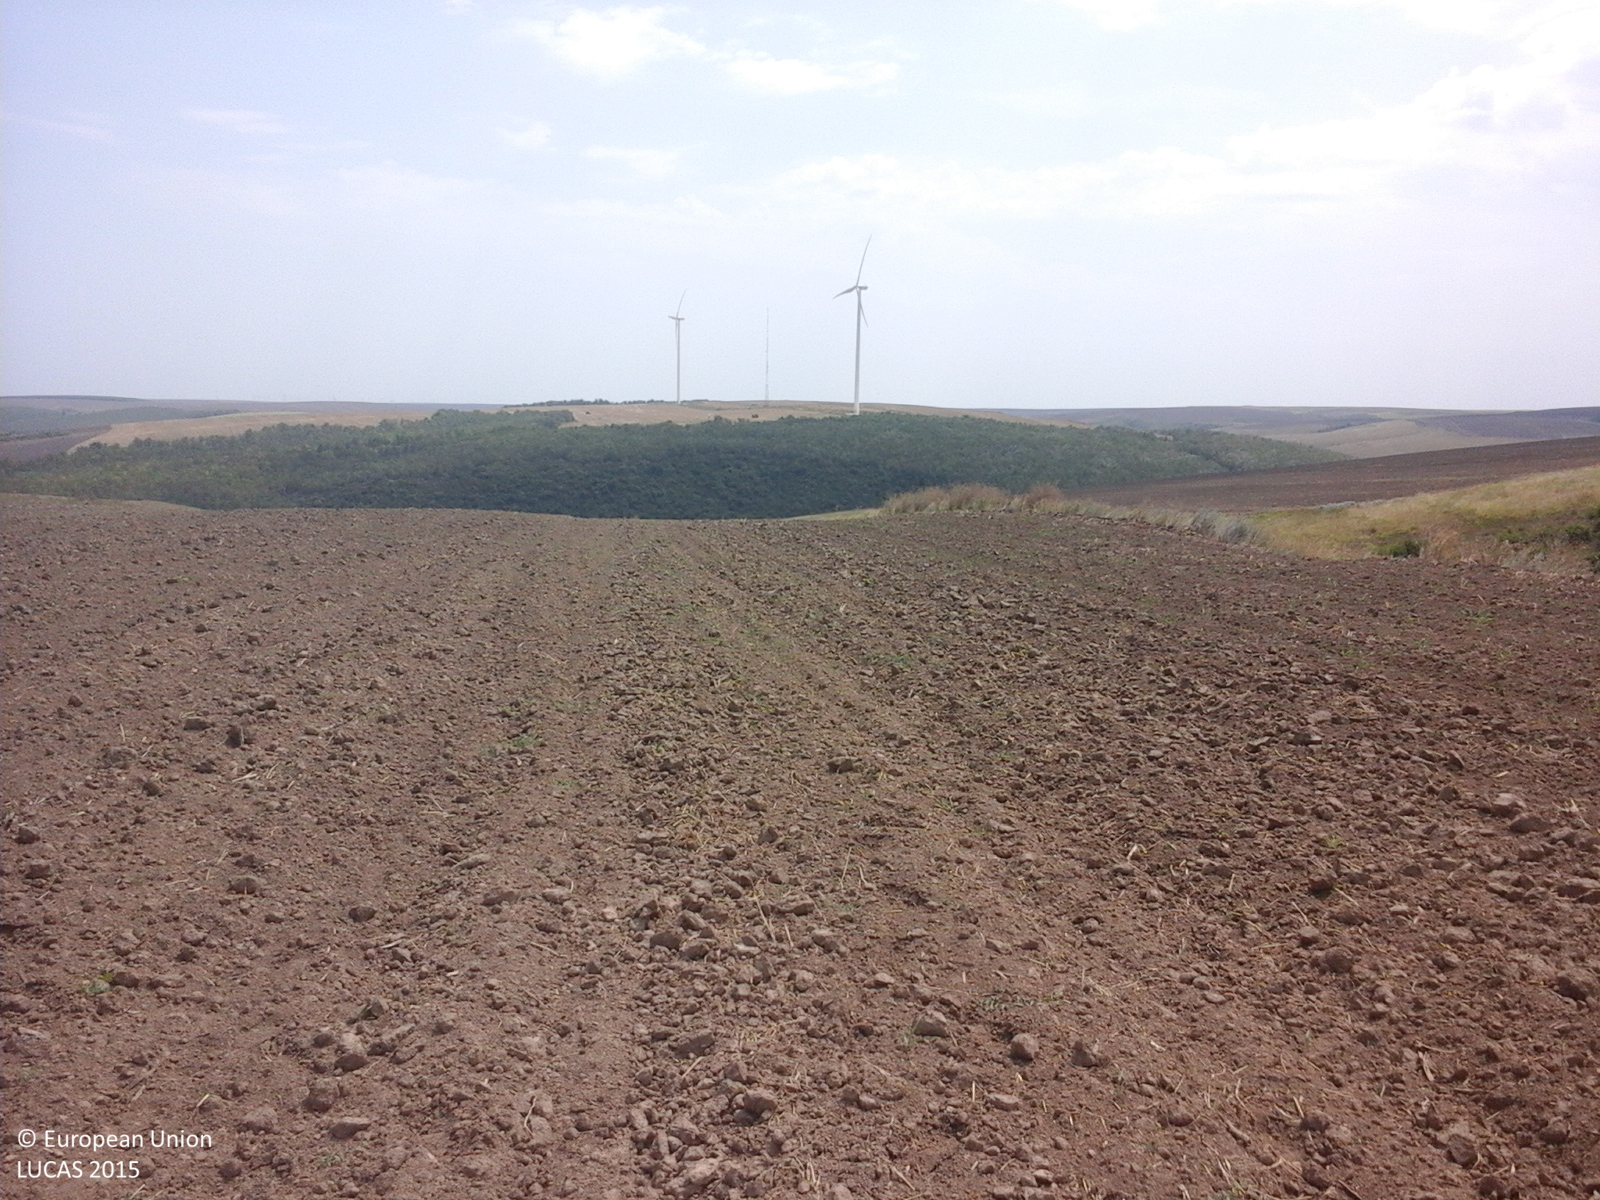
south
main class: Cropland
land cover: Common wheat
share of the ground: < 10 %
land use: Agriculture (excluding fallow land and kitchen gardens)
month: August
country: RO
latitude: 44.2149
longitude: 28.0155
